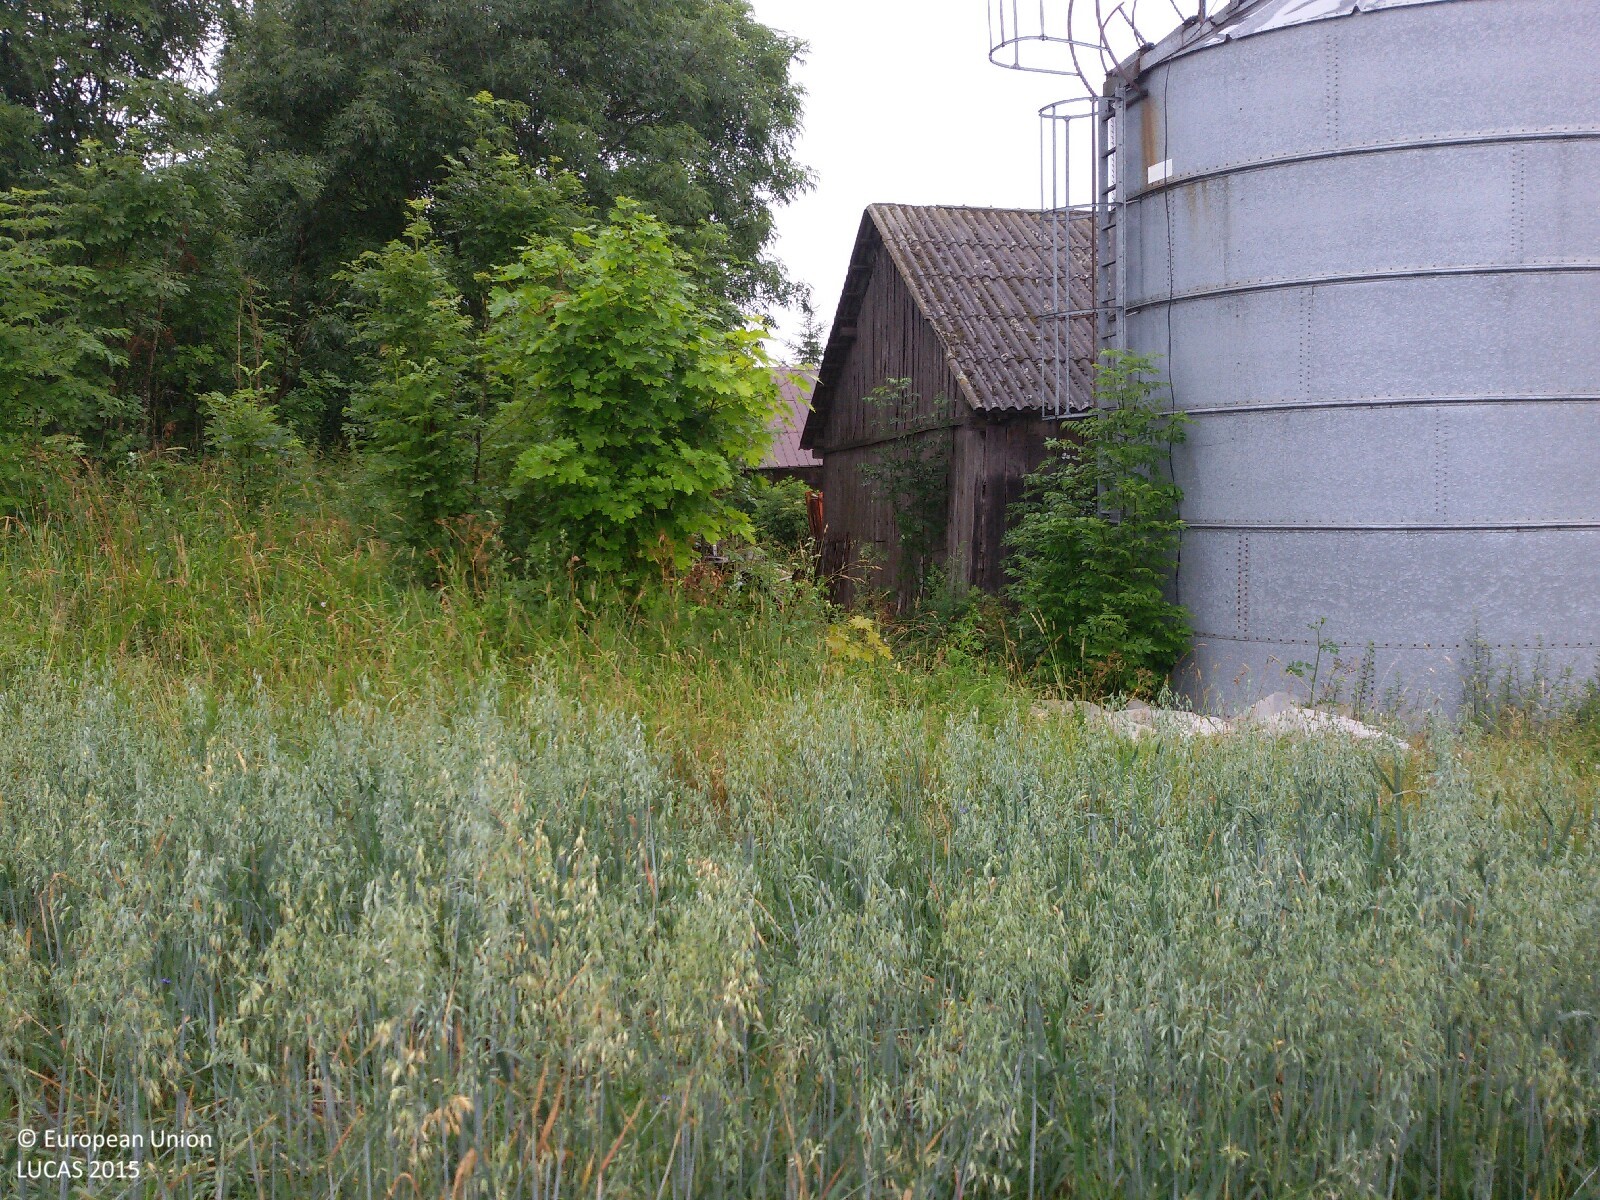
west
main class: Cropland
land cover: Oats
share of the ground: > 75 %
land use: Agriculture (excluding fallow land and kitchen gardens)
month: July
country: PL
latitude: 53.9265
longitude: 20.2524
